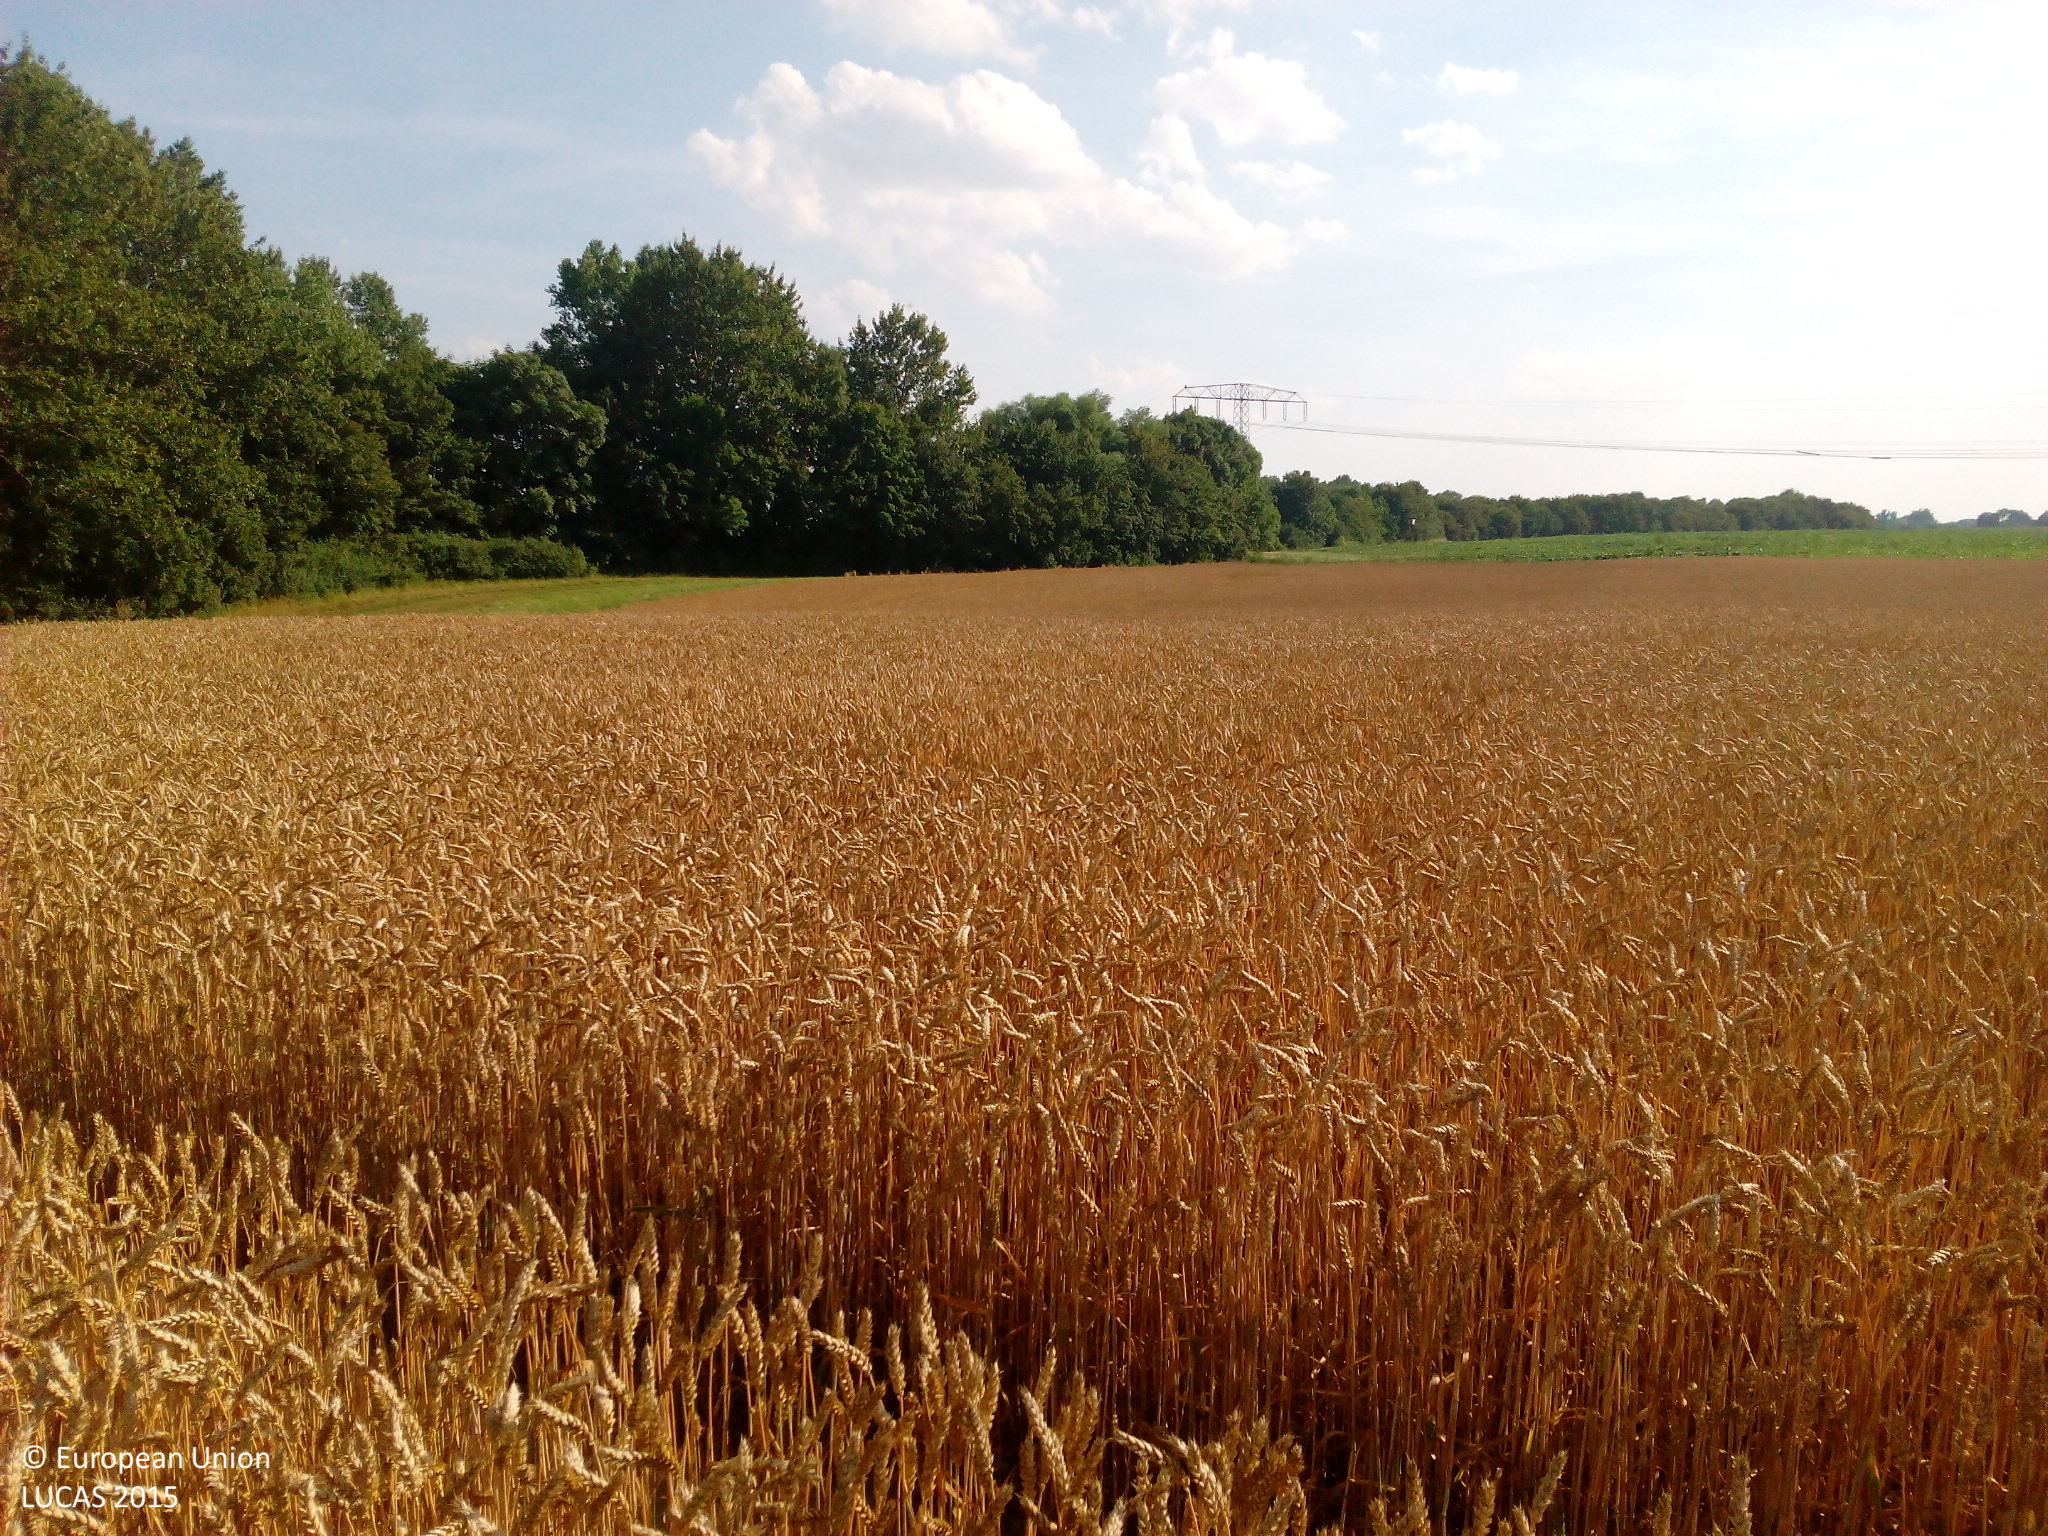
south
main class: Cropland
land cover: Common wheat
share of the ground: > 75 %
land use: Agriculture (excluding fallow land and kitchen gardens)
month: August
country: DE
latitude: 53.6180
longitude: 13.6129
